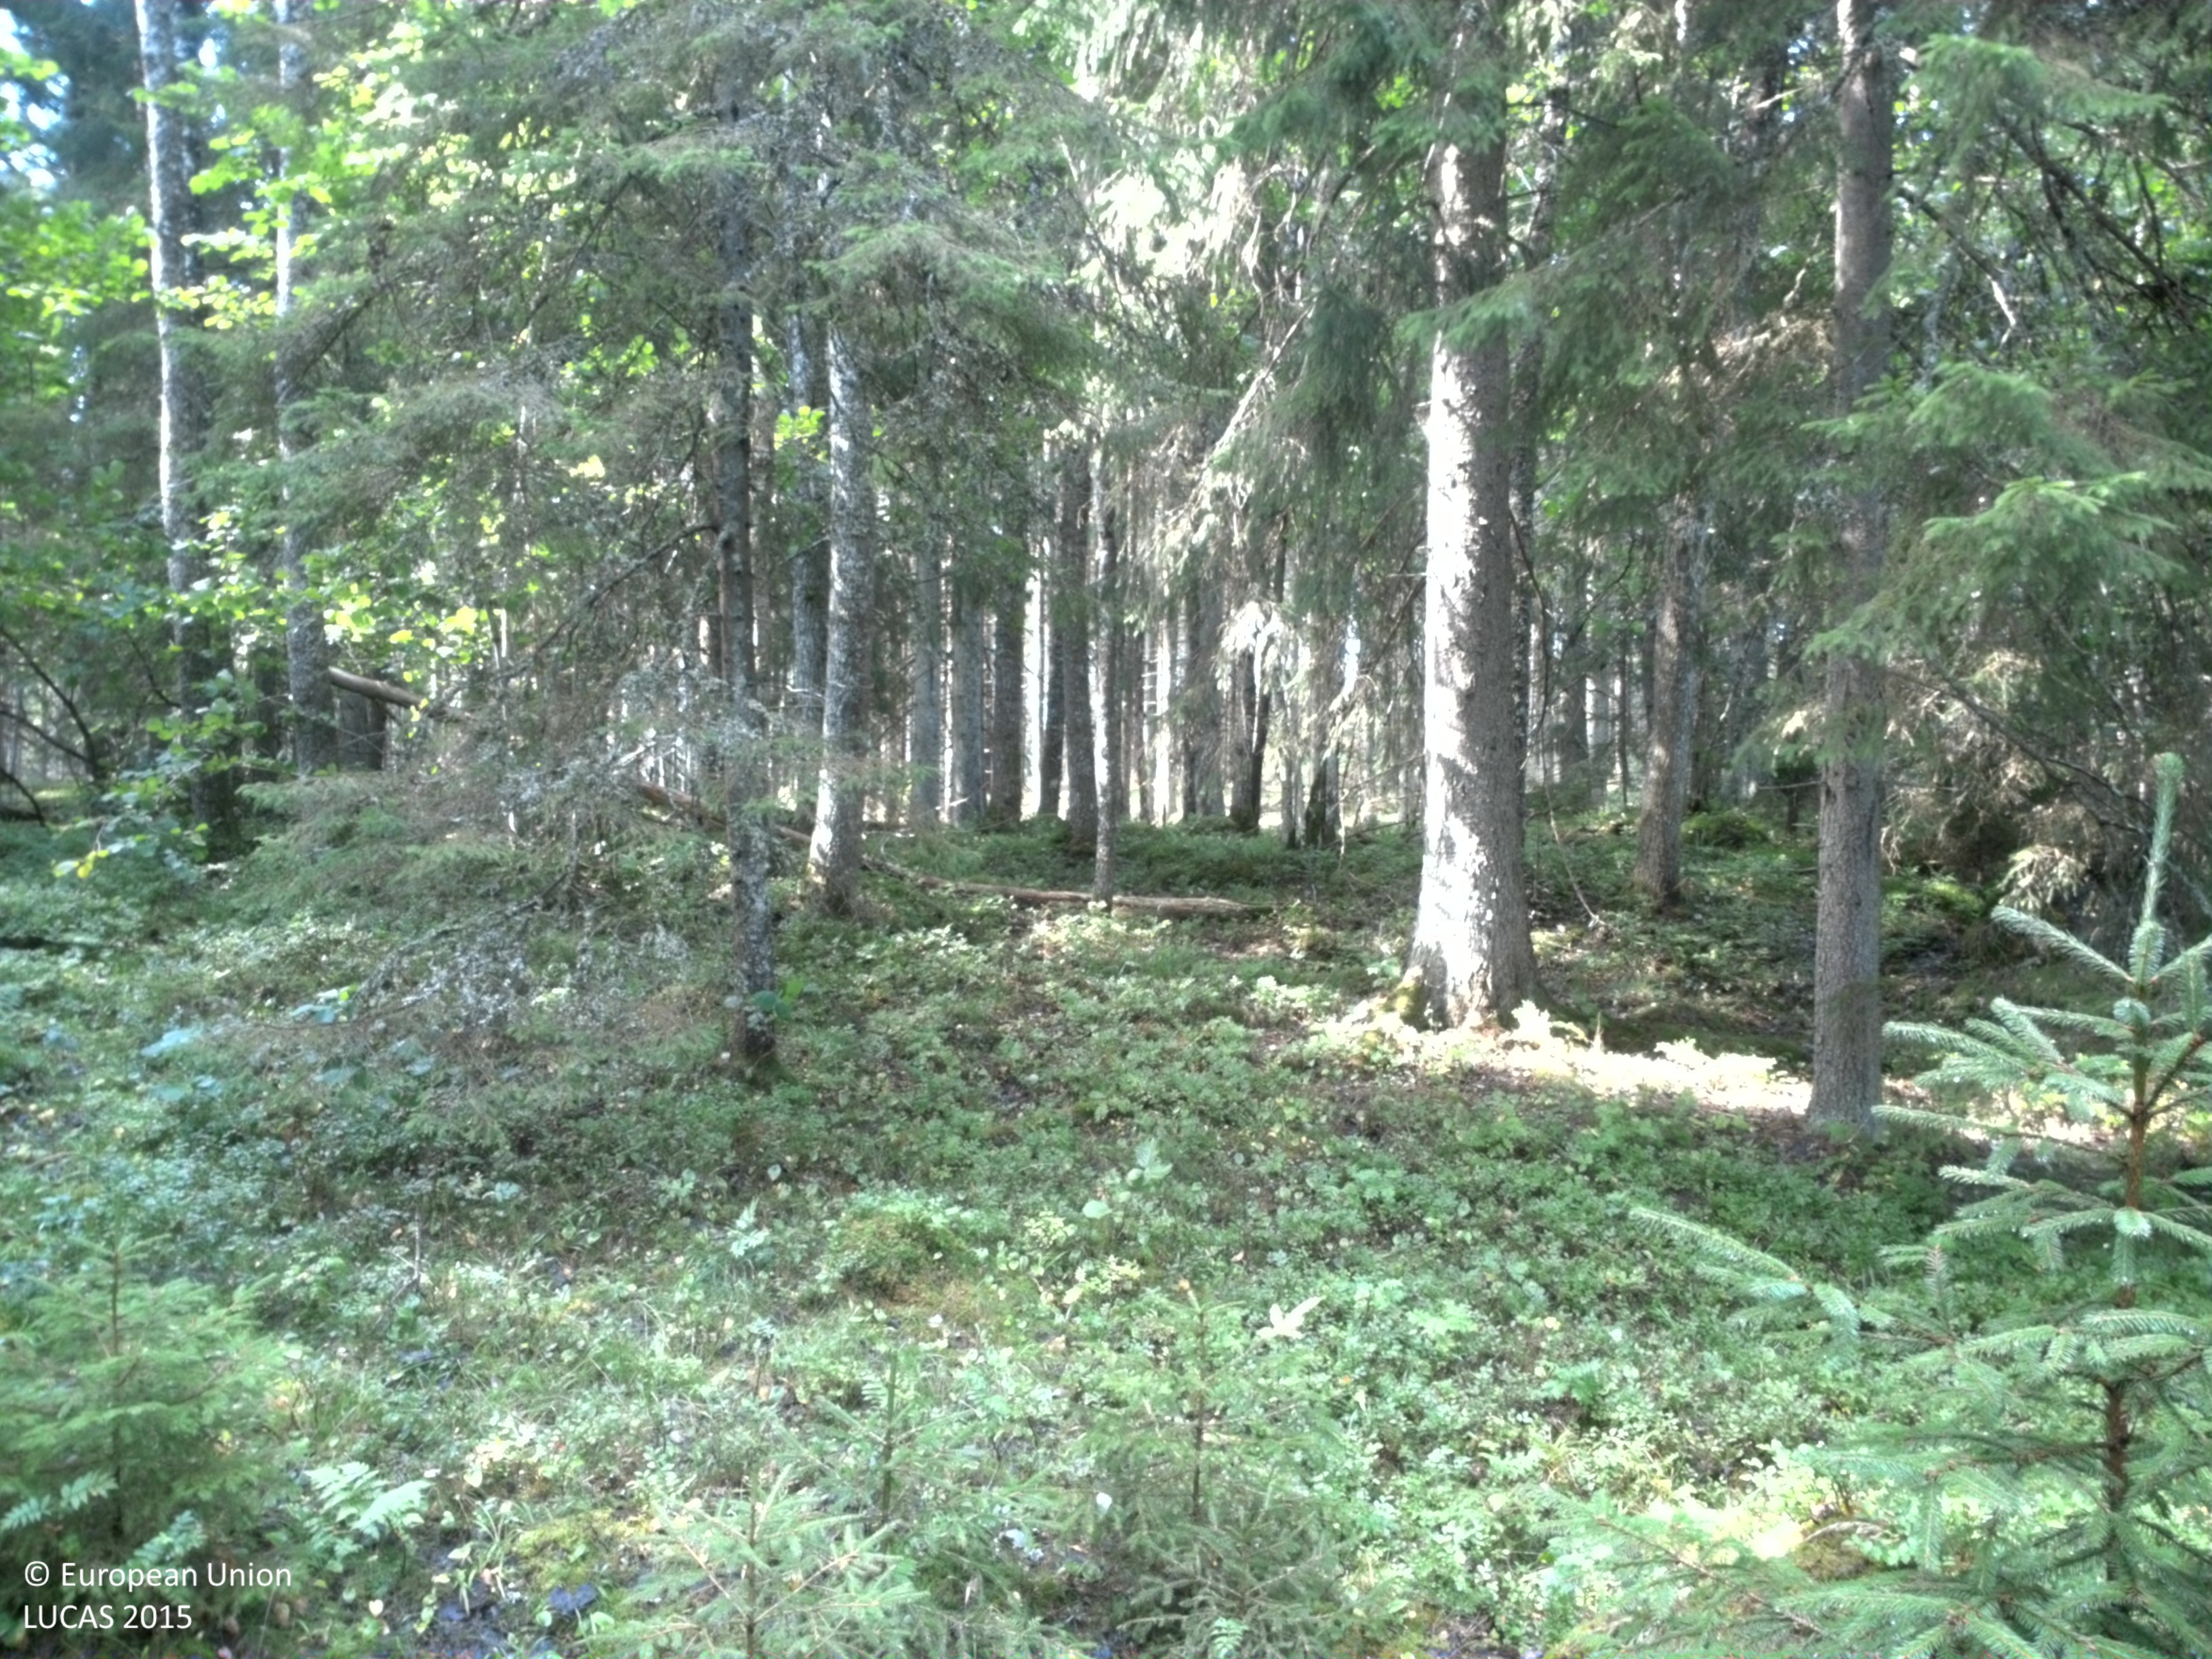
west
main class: Woodland
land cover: Spruce dominated mixed woodland
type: boreal forest
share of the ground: 25 - 50 %
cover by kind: coniferous forest trees 25 %, broadleaved forest trees 25 %, herbaceous plants 20 %, lichens and mosses 20 %, shrubs 10 %
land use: Agriculture (excluding fallow land and kitchen gardens)
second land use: Forestry
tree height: > 5 m
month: August
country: SE
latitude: 57.9450
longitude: 13.9646
